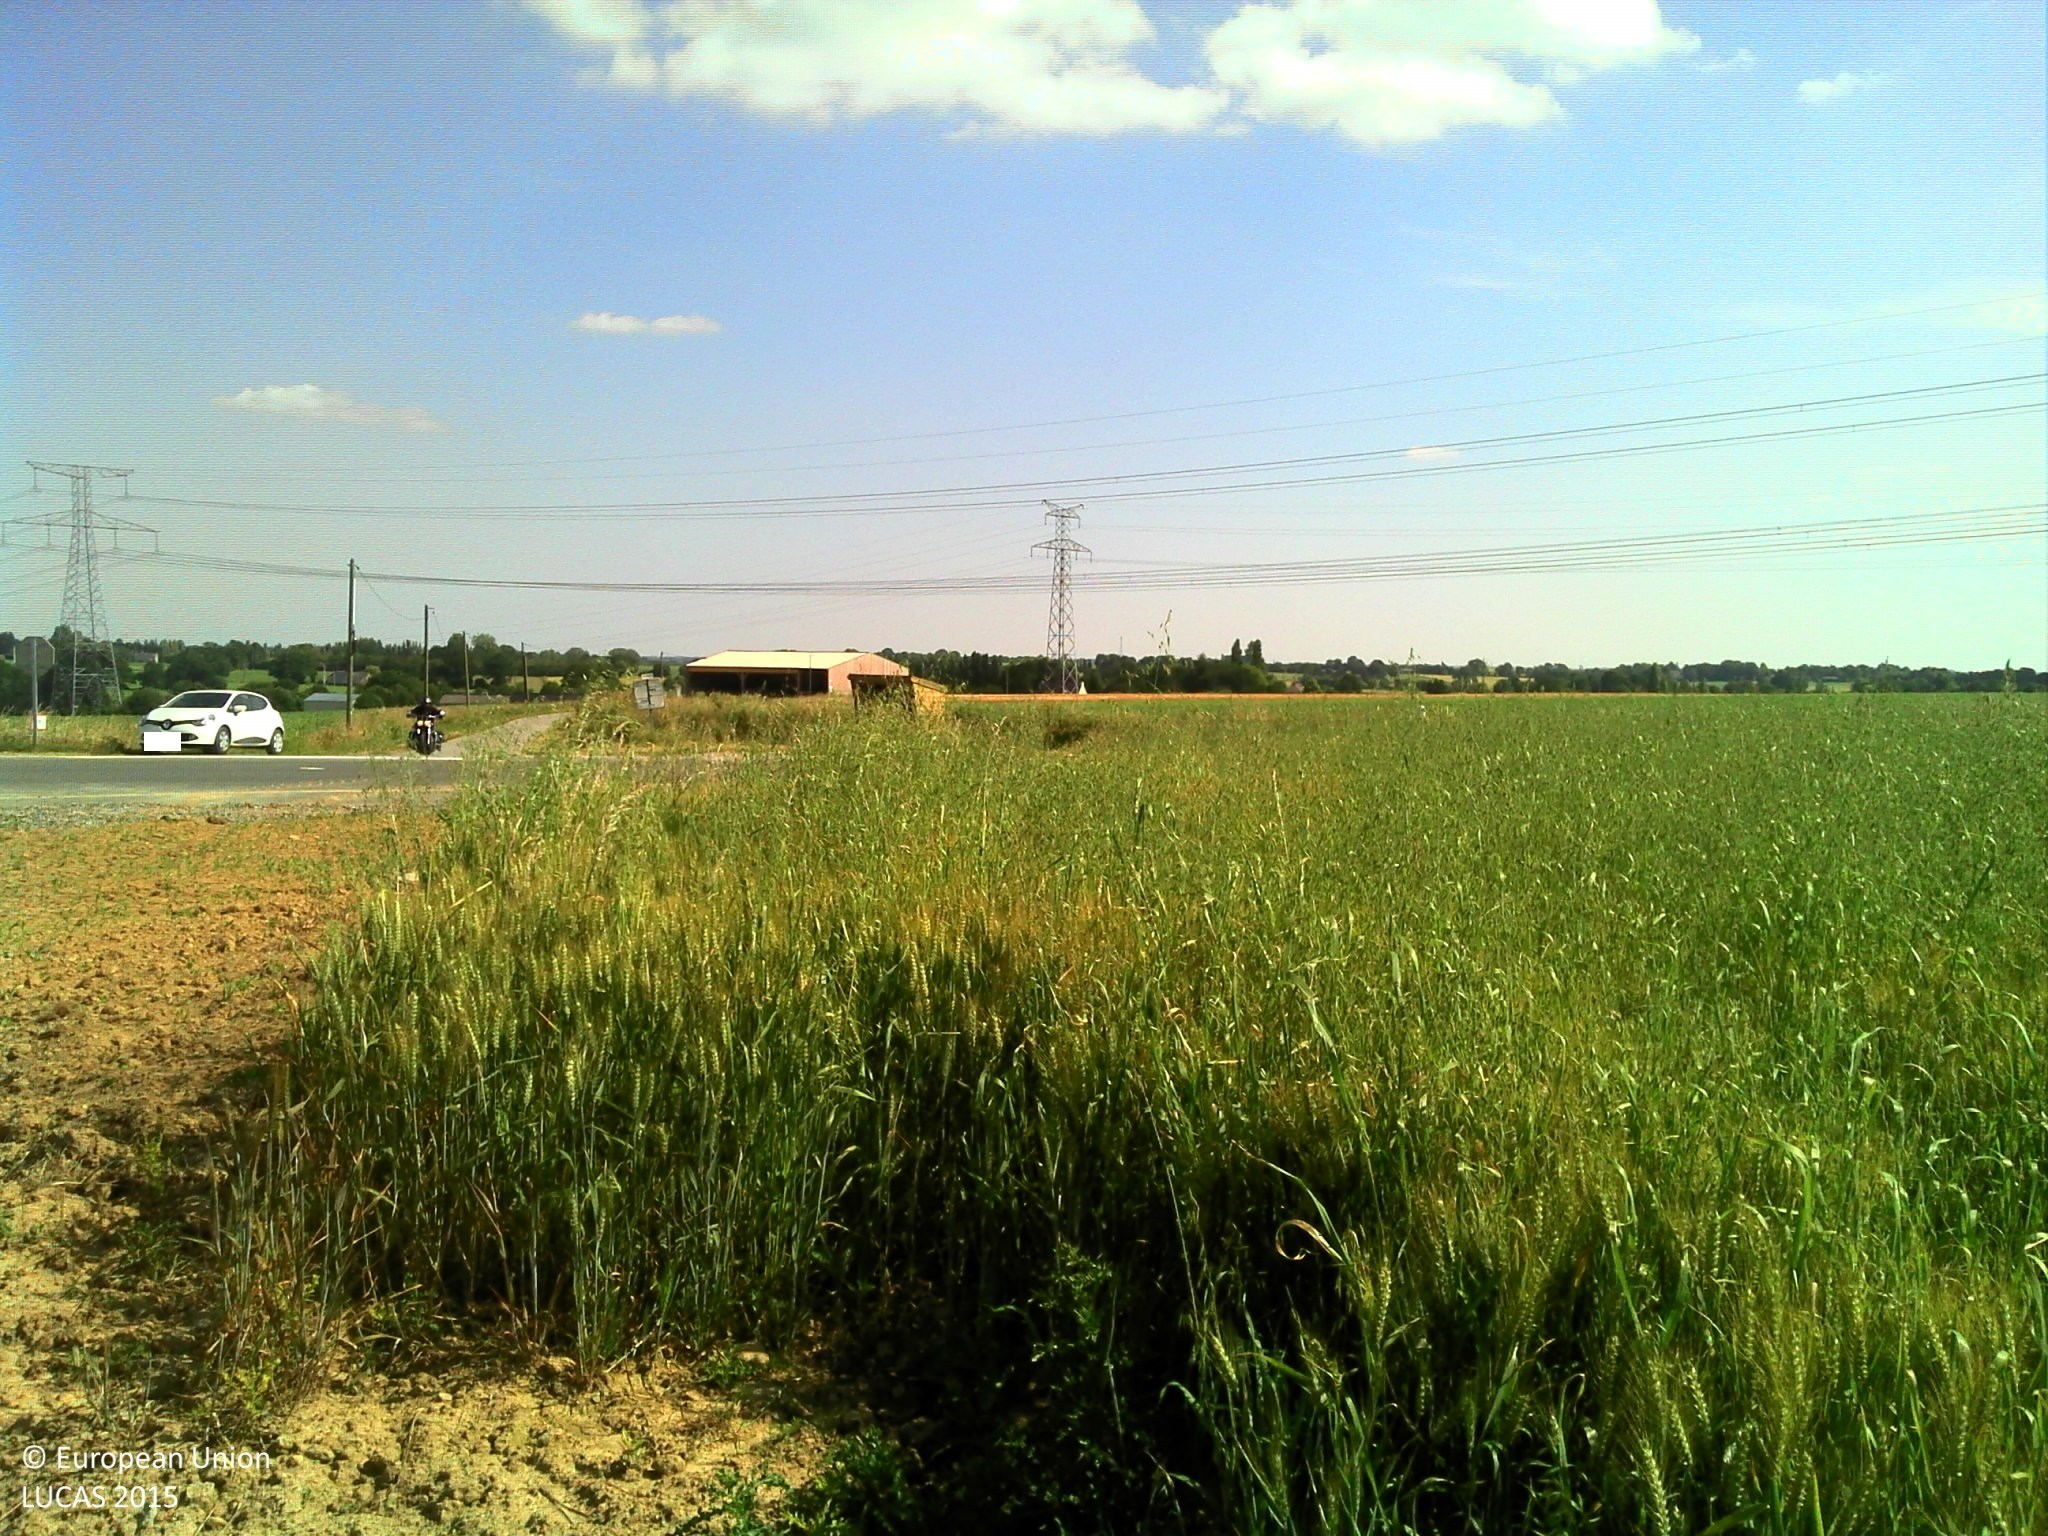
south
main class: Cropland
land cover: Maize
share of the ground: 10 - 25 %
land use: Agriculture (excluding fallow land and kitchen gardens)
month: June
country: FR
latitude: 48.0623
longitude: -1.4370
